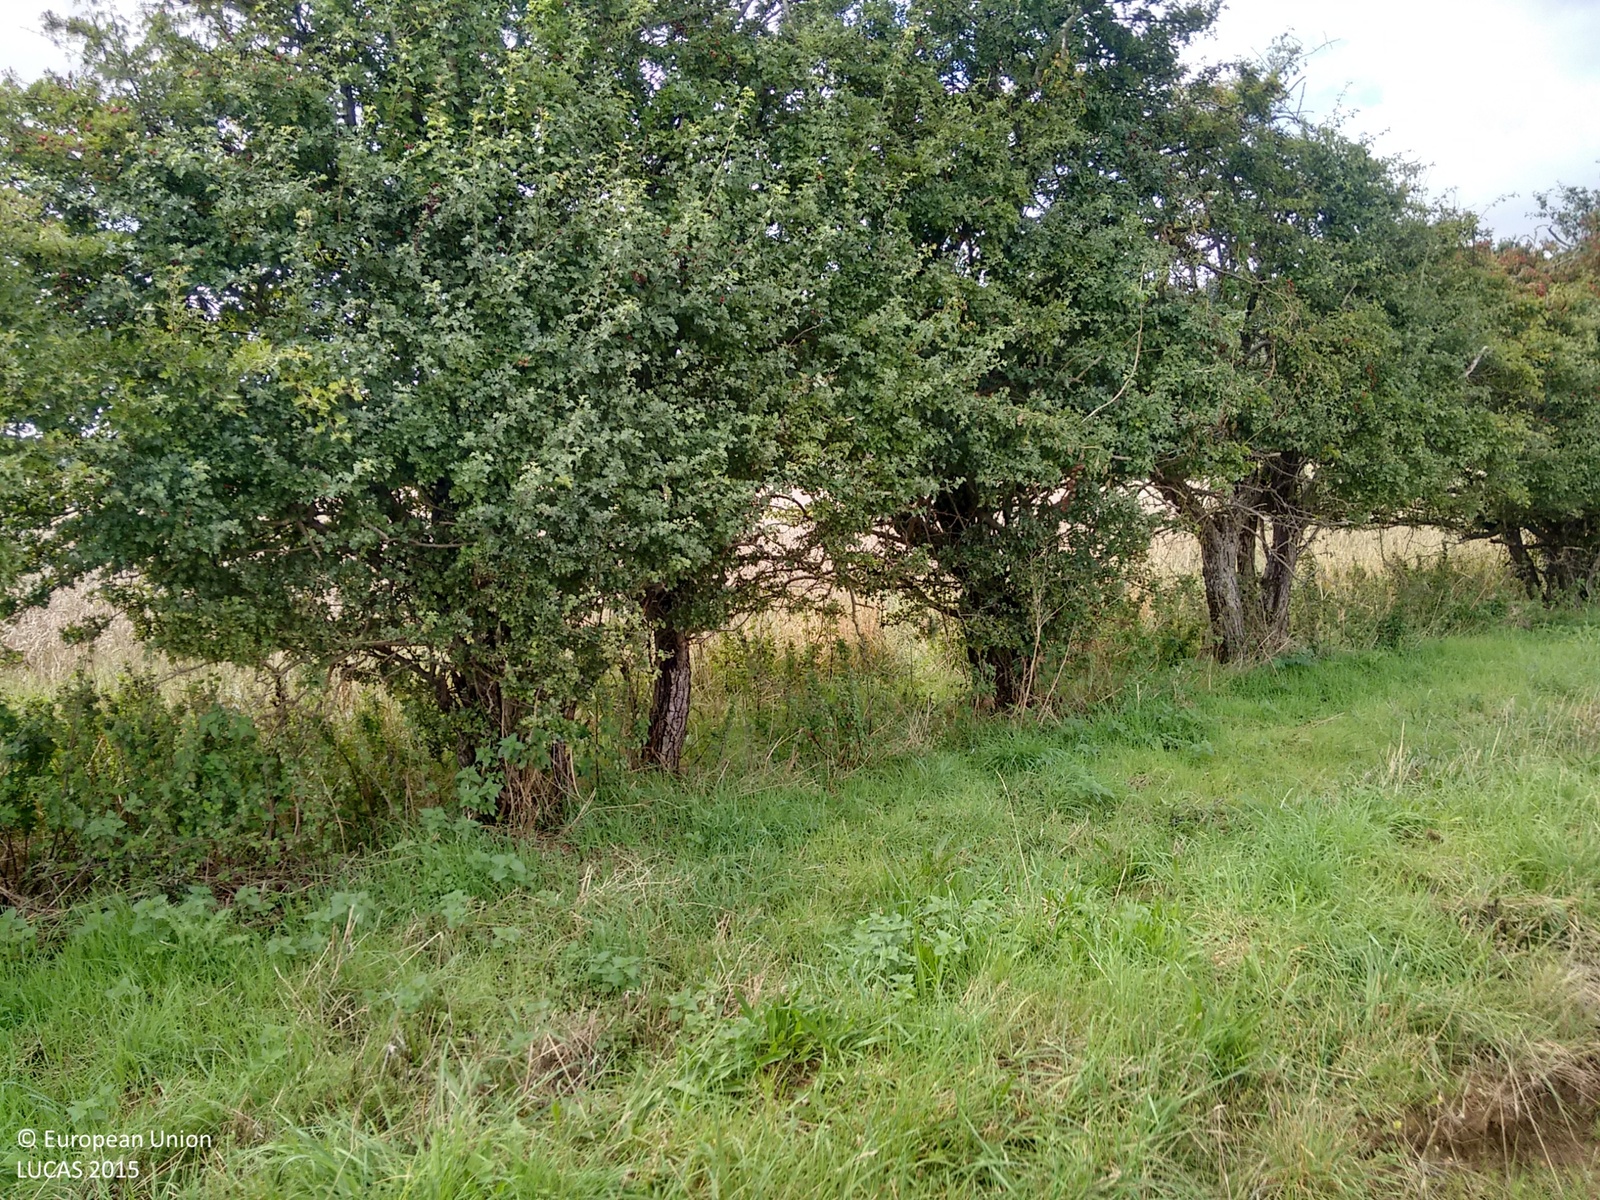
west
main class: Cropland
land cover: Barley
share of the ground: > 75 %
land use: Agriculture (excluding fallow land and kitchen gardens)
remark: Harvested field
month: September
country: GB
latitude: 52.2797
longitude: 0.4296
